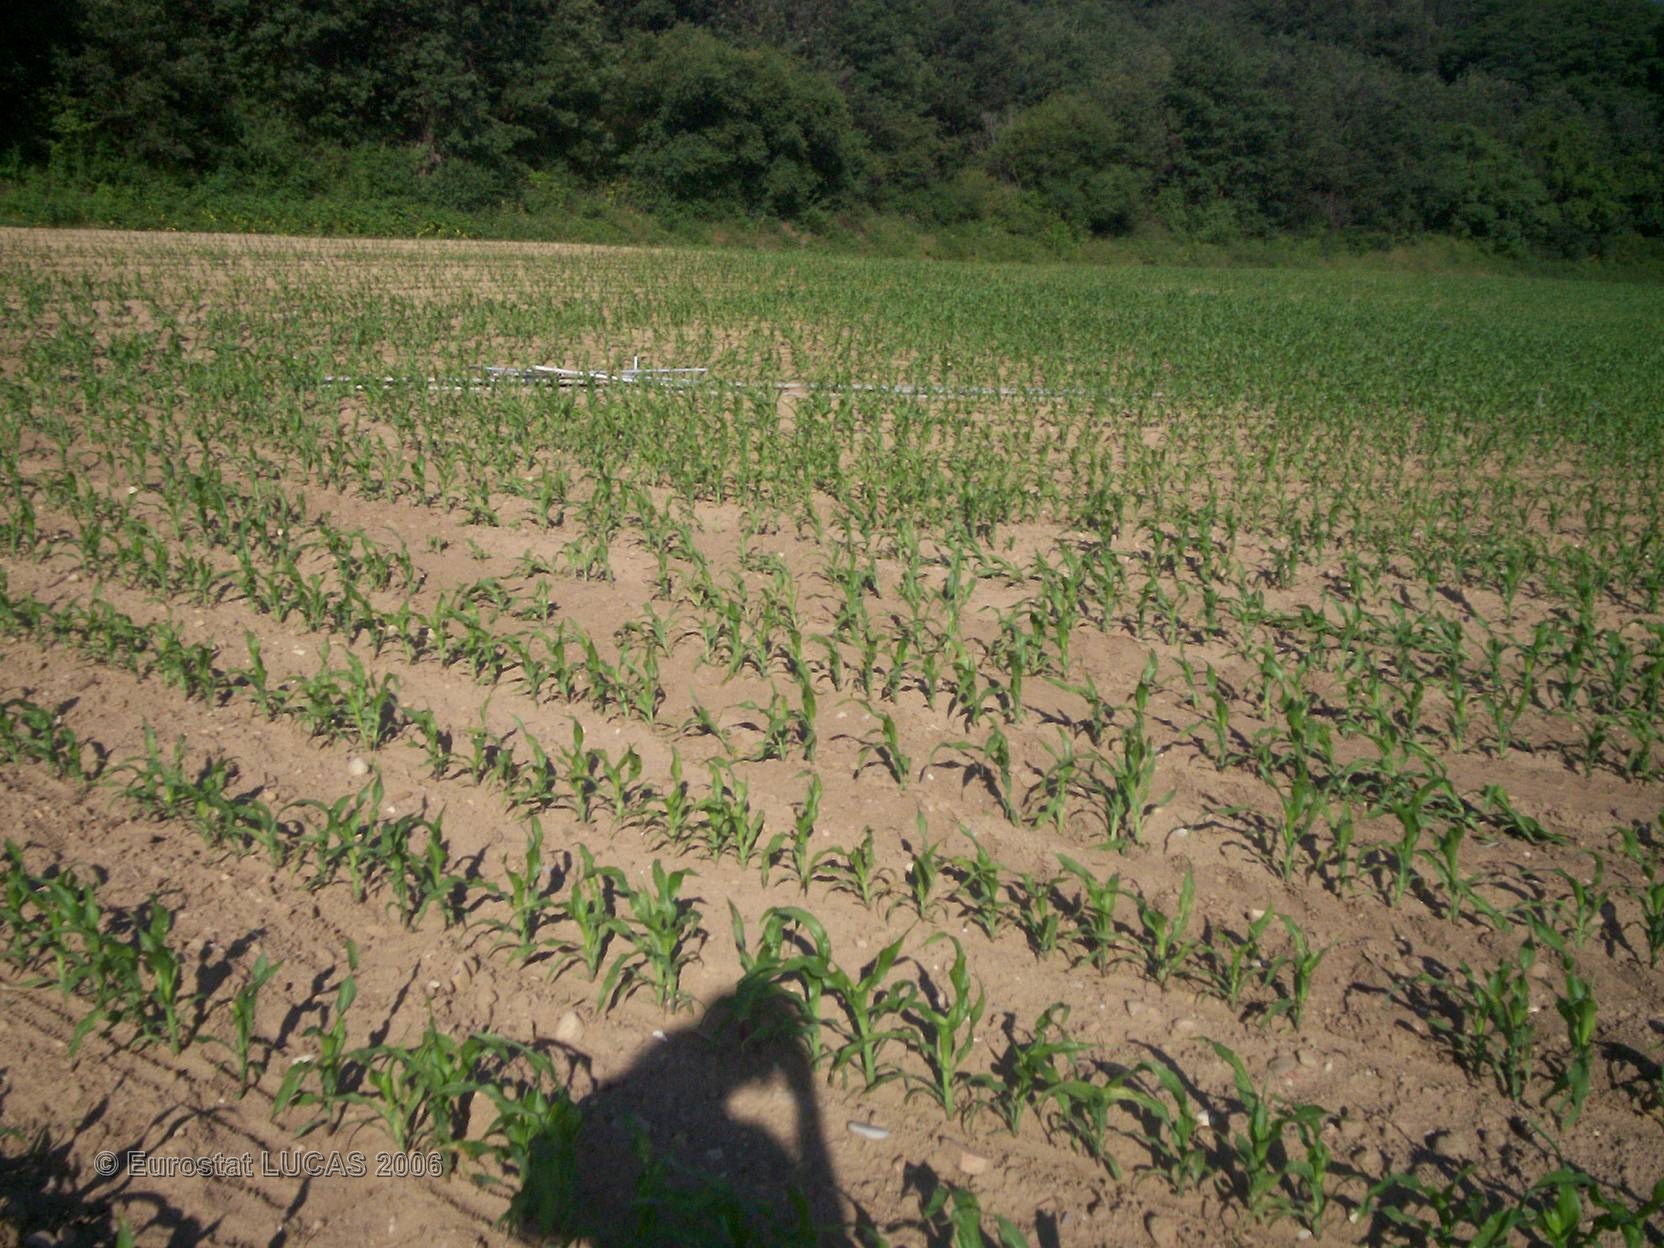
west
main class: Cropland
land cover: Maize
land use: Agriculture (excluding fallow land and kitchen gardens)
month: June
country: FR
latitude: 45.2149
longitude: 4.8224
